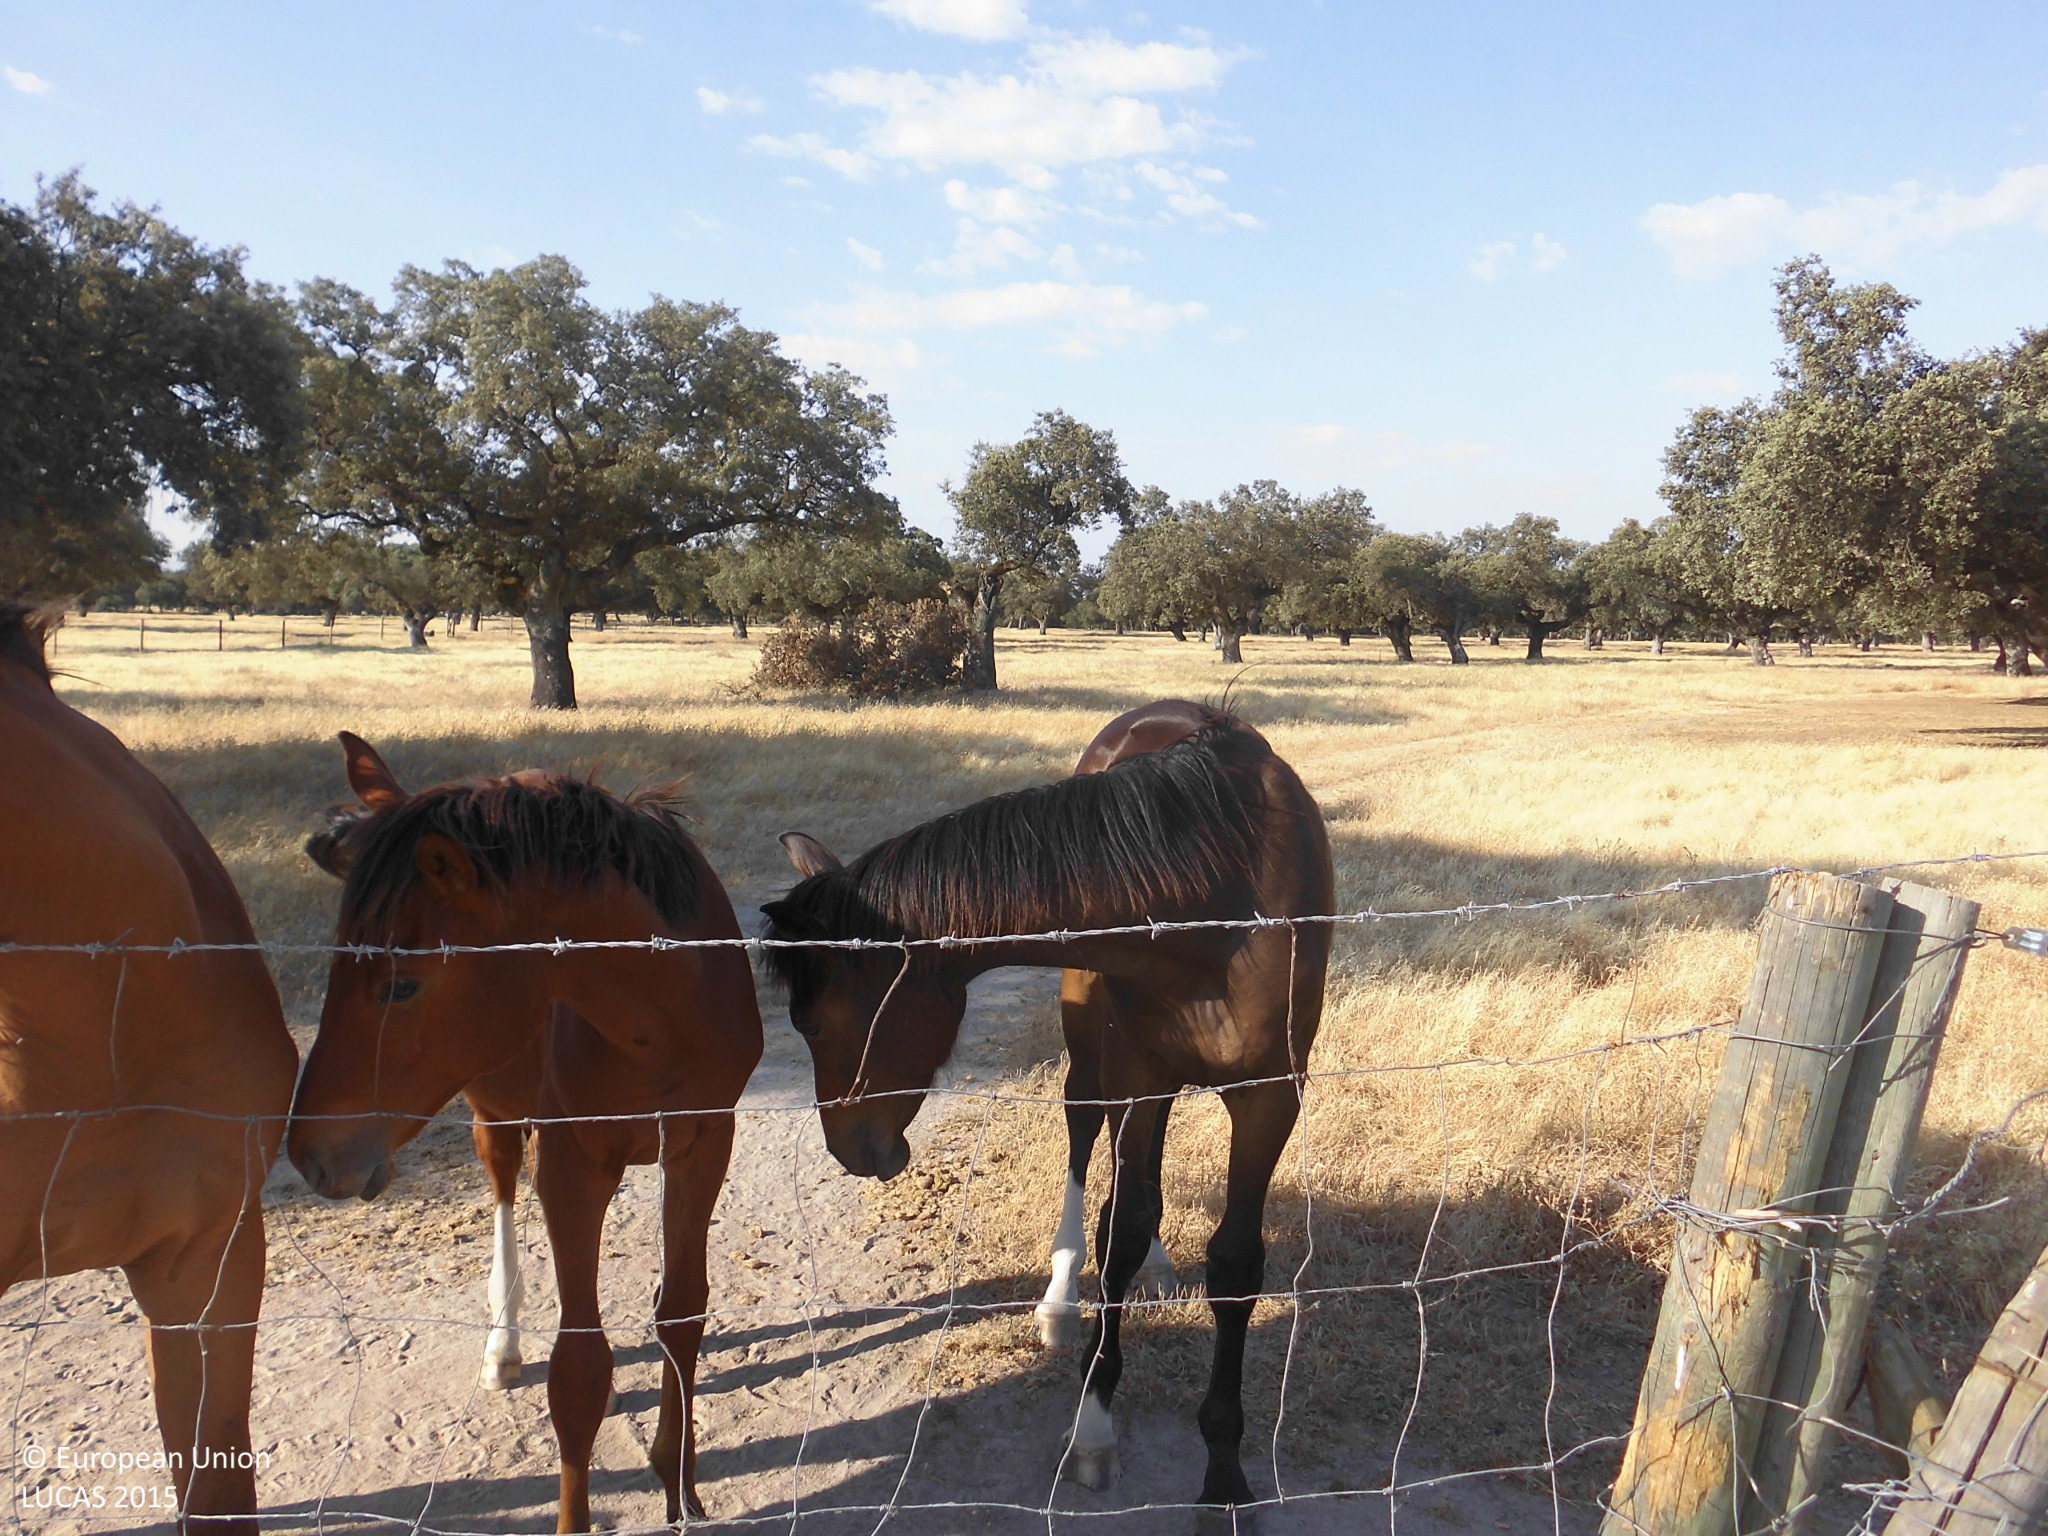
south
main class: Woodland
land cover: Broadleaved woodland
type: broadleaved evergreen forest
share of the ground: 25 - 50 %
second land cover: Grassland without tree/shrub cover
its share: > 75 %
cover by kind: herbaceous plants 70 %, broadleaved forest trees 30 %
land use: Forestry
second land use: Agriculture (excluding fallow land and kitchen gardens)
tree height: > 5 m
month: June
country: ES
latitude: 39.9578
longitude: -5.4279
